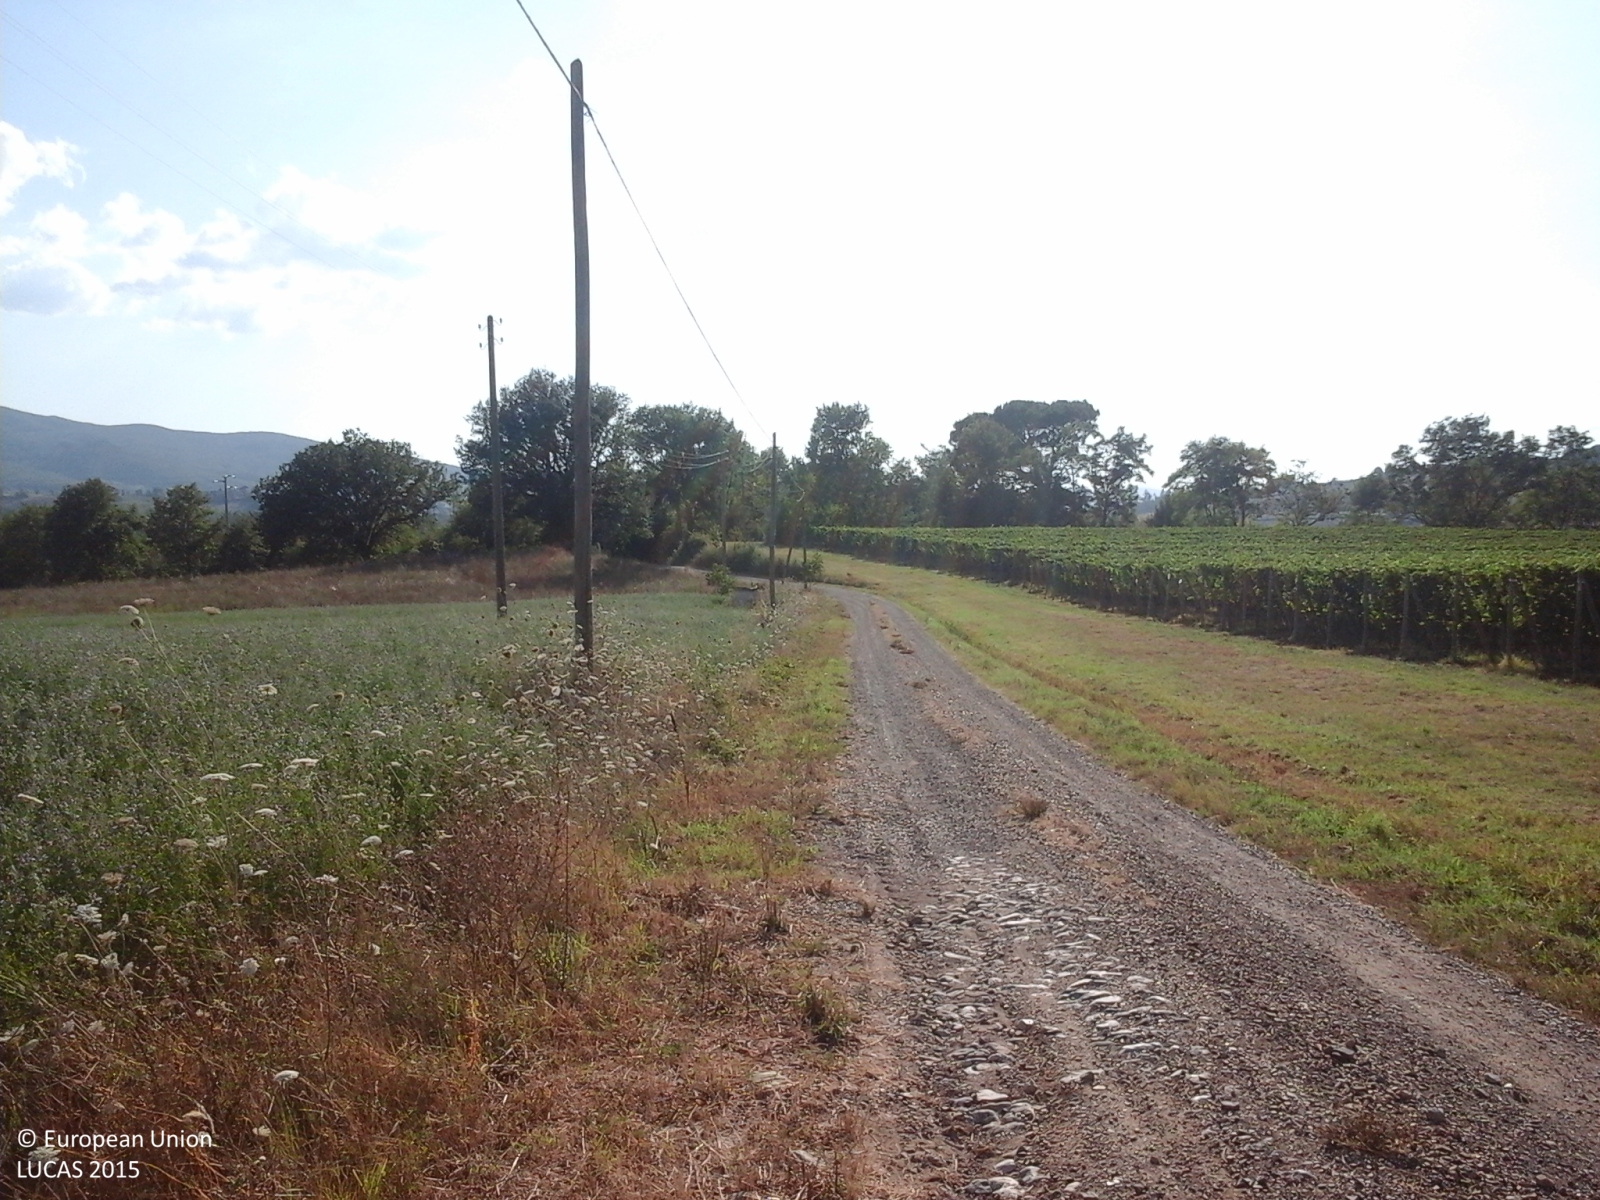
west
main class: Cropland
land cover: Lucerne
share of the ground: > 75 %
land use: Agriculture (excluding fallow land and kitchen gardens)
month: August
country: IT
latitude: 43.1127
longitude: 11.4825
